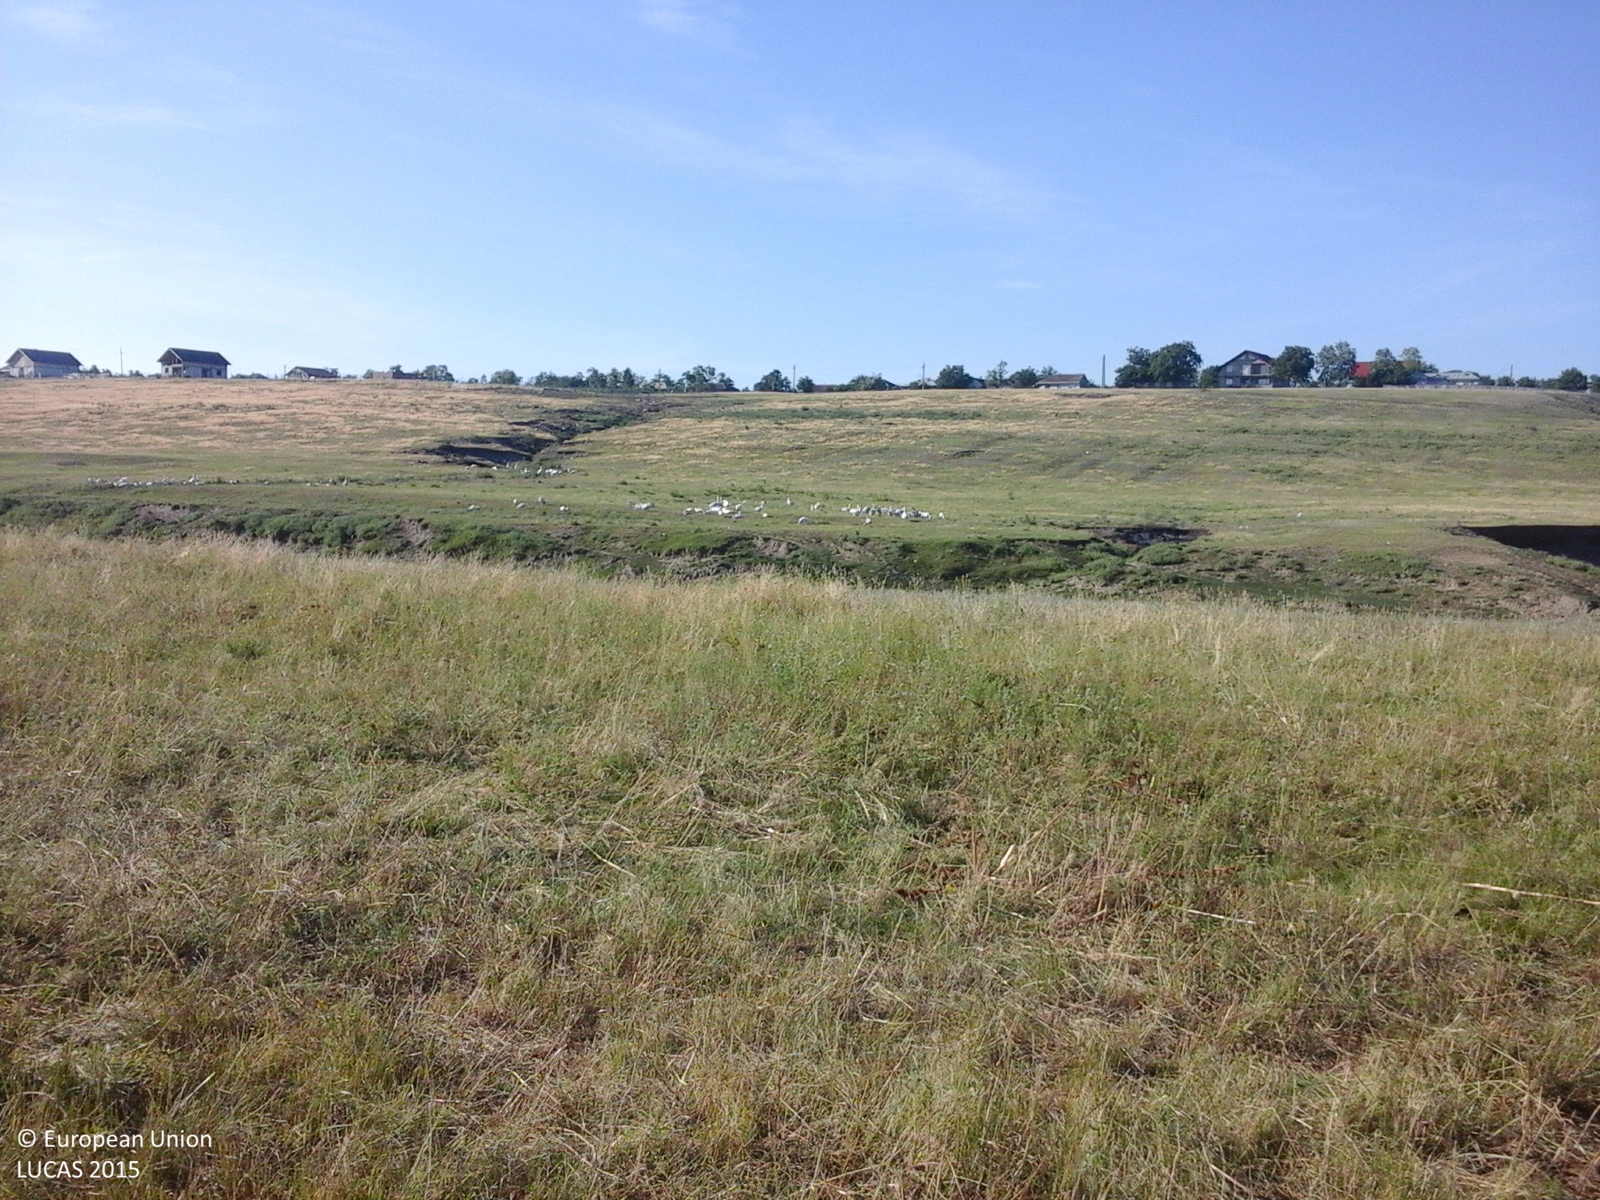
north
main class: Grassland
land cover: Grassland without tree/shrub cover
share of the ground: > 75 %
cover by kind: herbaceous plants 100 %
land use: Agriculture (excluding fallow land and kitchen gardens)
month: June
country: RO
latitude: 47.5981
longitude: 27.1728
